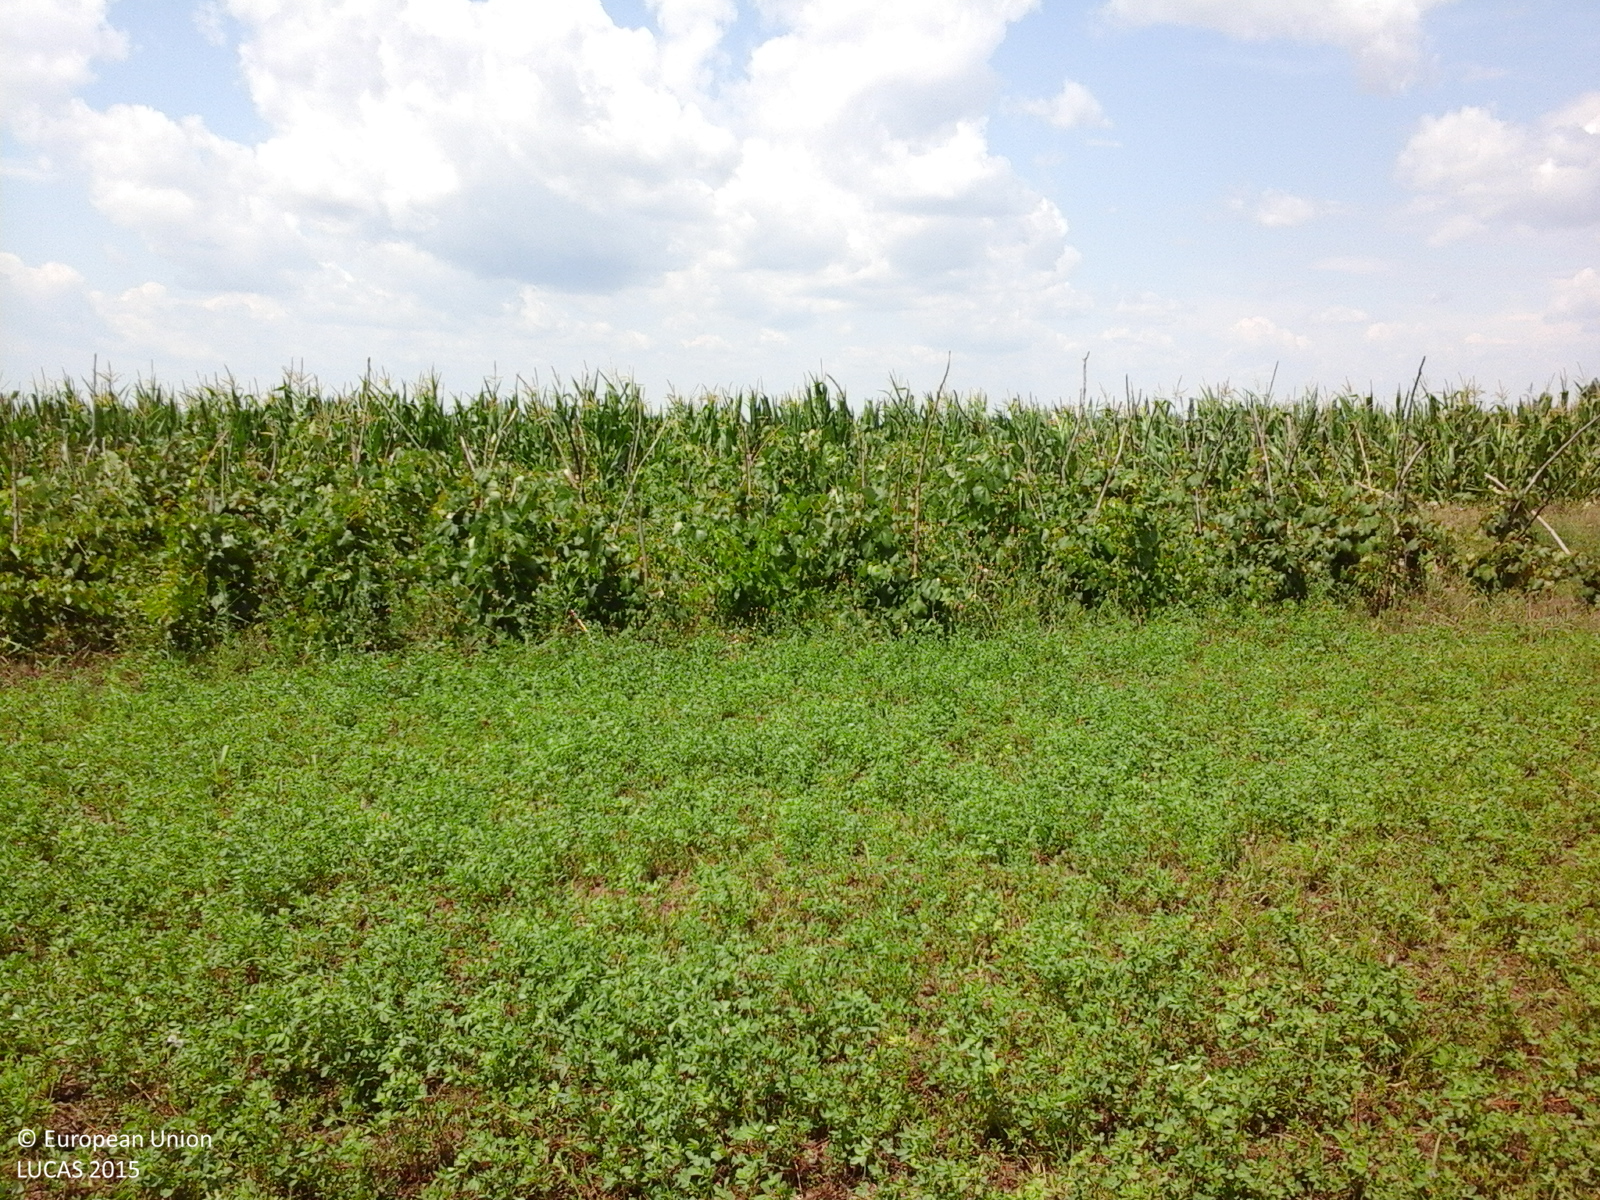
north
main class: Cropland
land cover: Common wheat
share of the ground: > 75 %
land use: Agriculture (excluding fallow land and kitchen gardens)
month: July
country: RO
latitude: 43.9366
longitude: 24.5805
